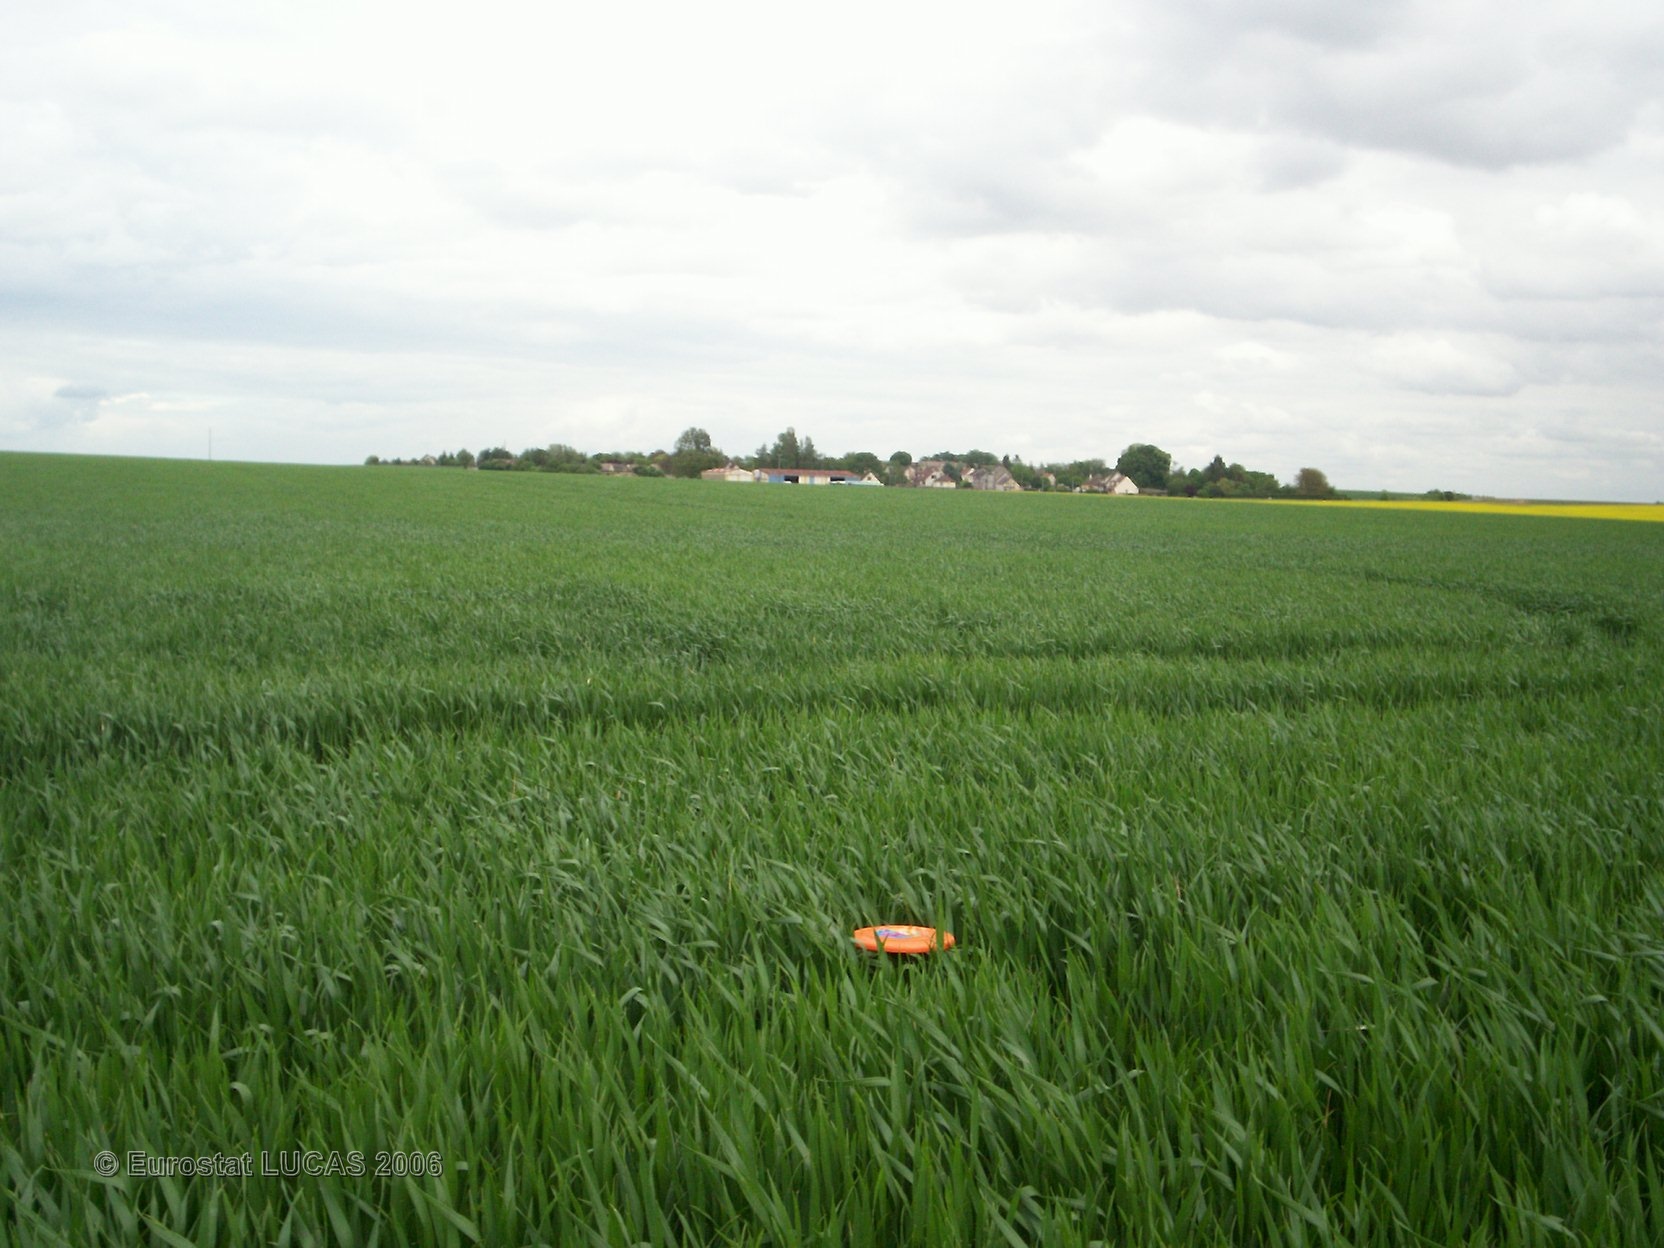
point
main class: Cropland
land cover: Common wheat
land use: Agriculture (excluding fallow land and kitchen gardens)
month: May
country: FR
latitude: 49.1060
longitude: 2.7710
